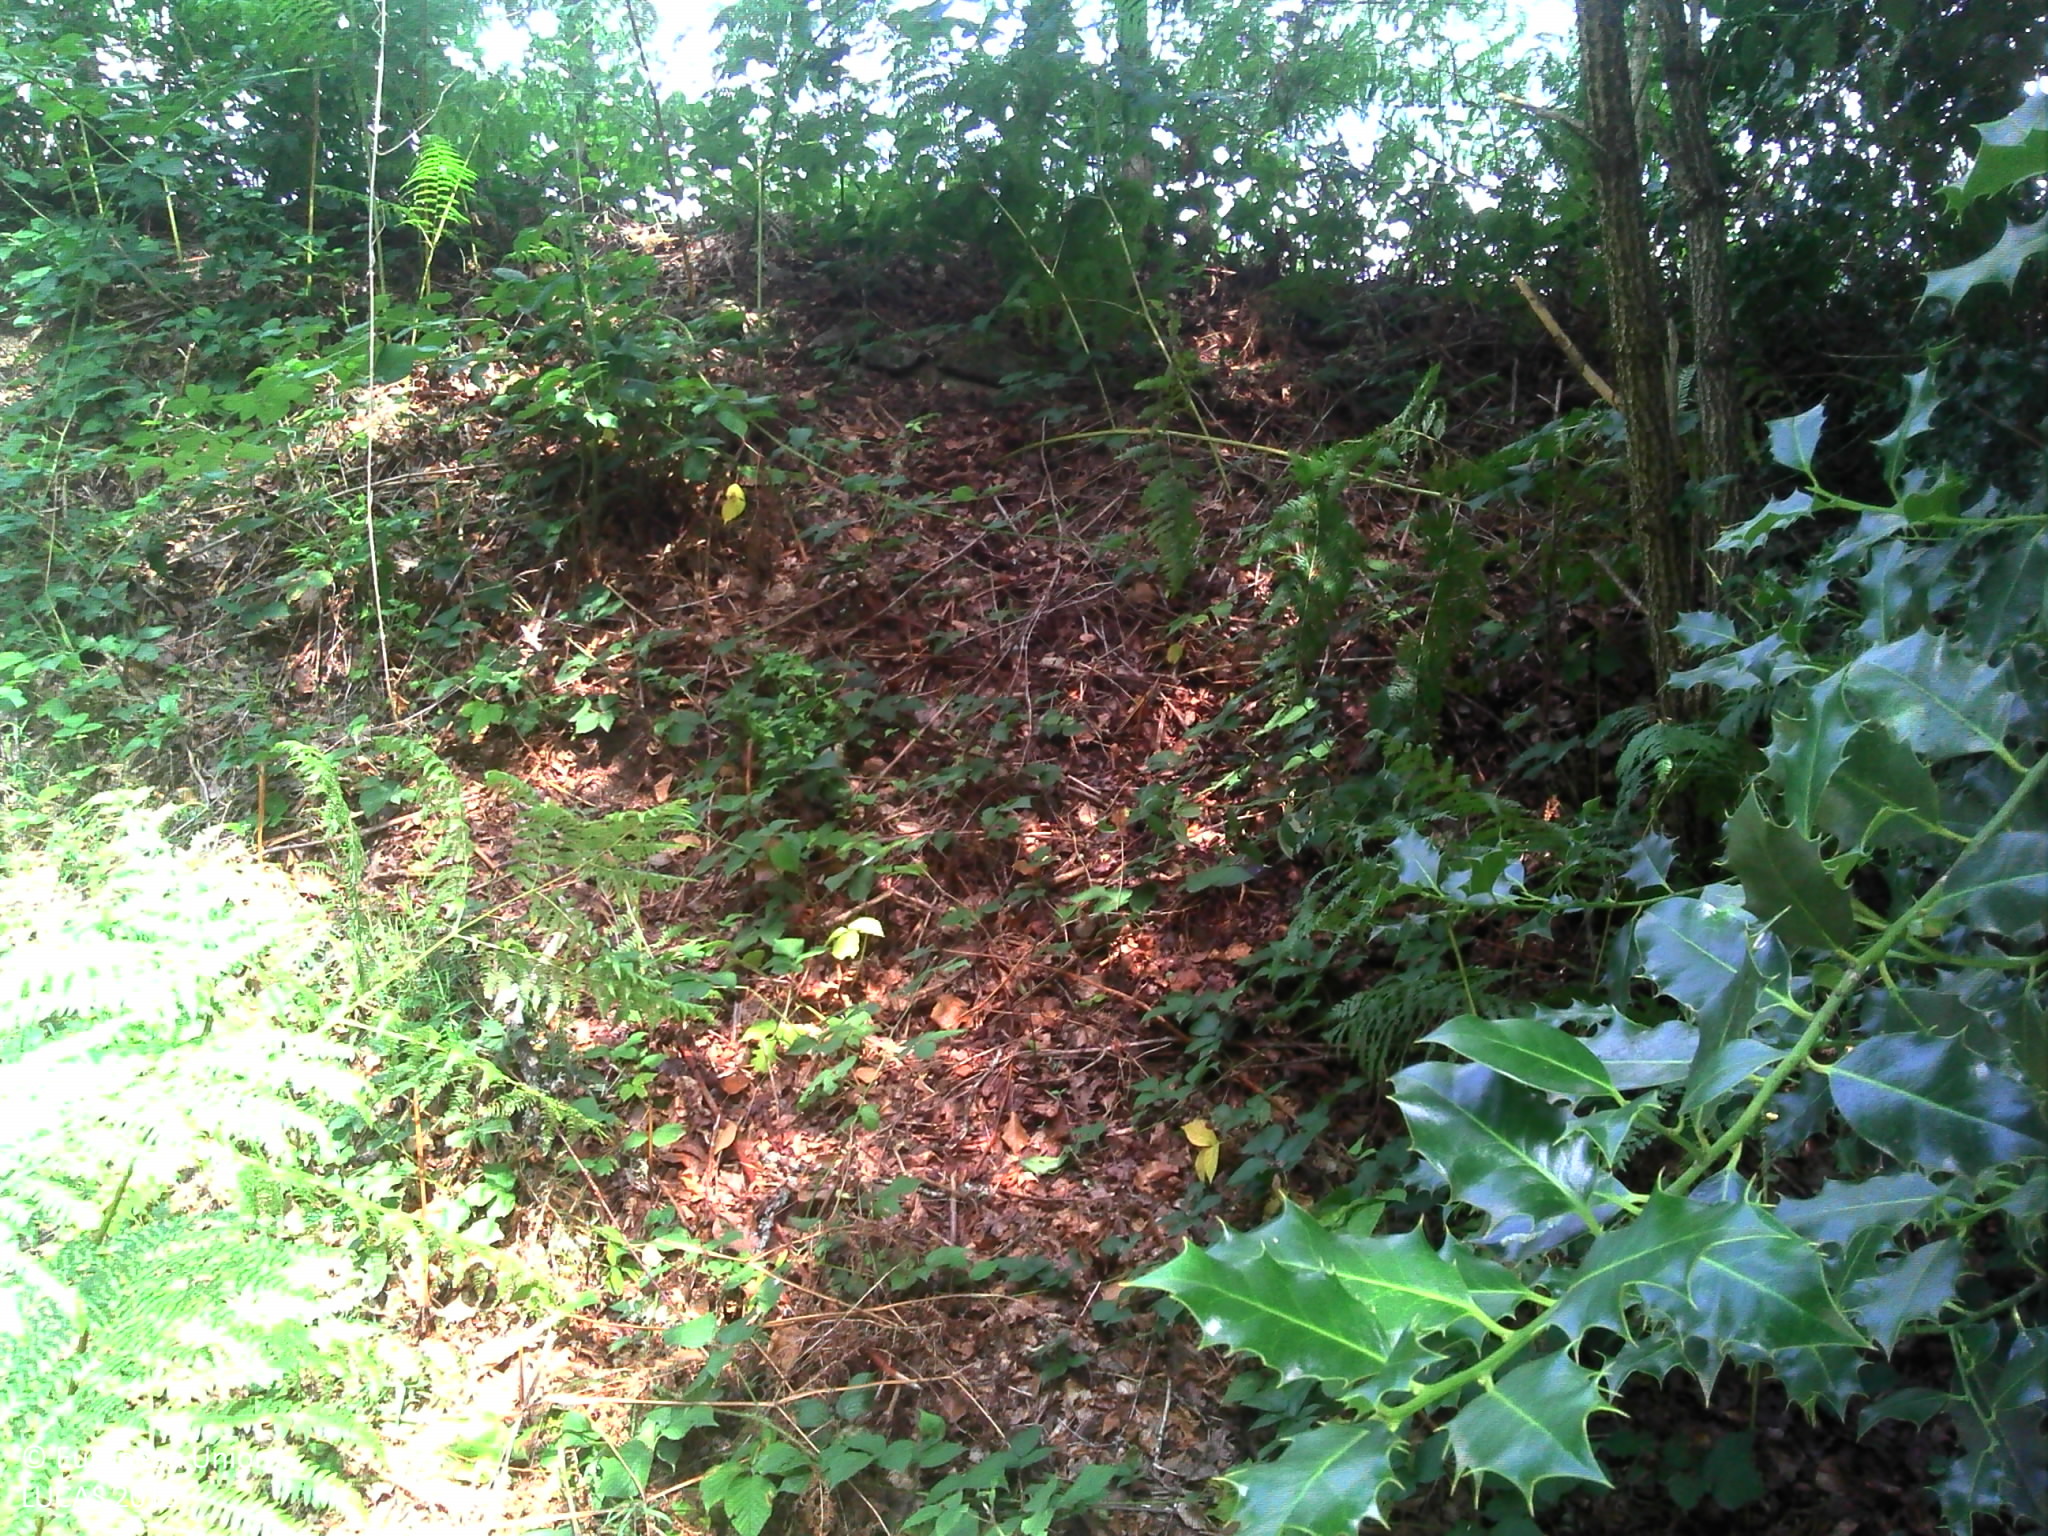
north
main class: Grassland
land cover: Spontaneously vegetated surfaces
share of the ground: > 75 %
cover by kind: herbaceous plants 95 %, shrubs 5 %
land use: Semi-natural and natural areas not in use
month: August
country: FR
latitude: 45.8323
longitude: 1.7417
